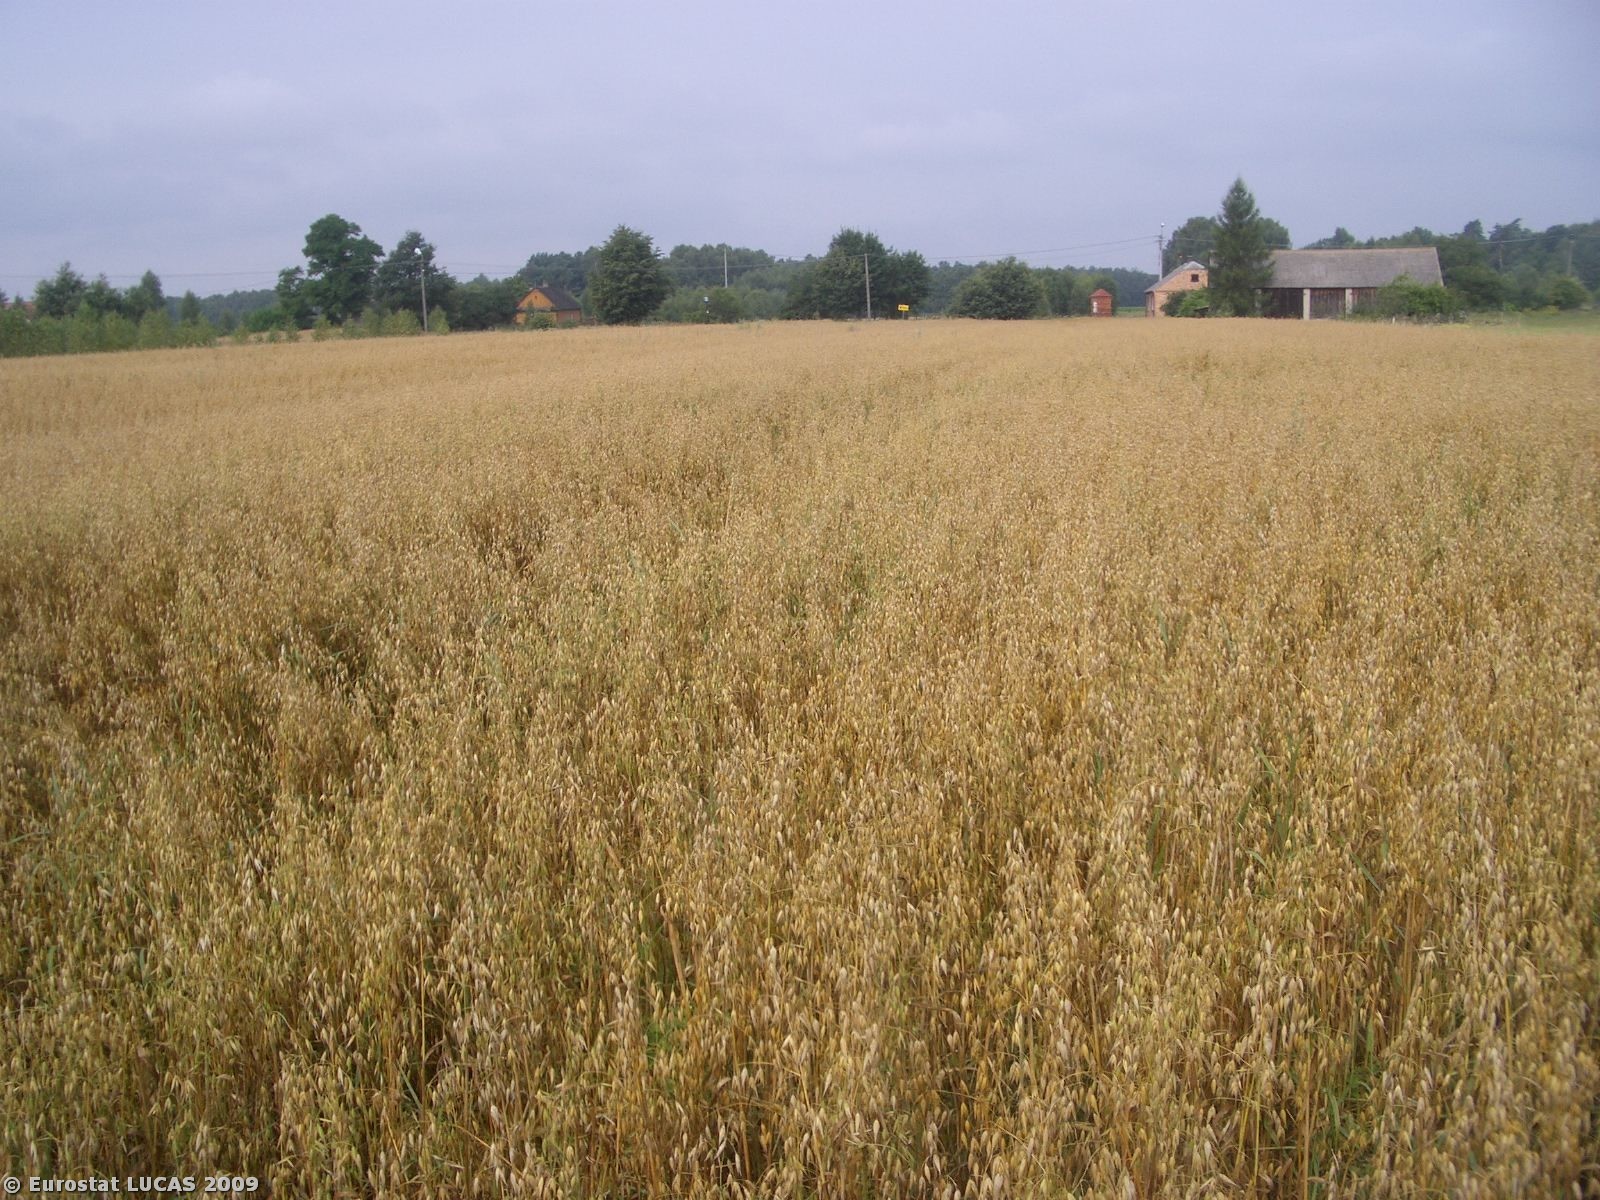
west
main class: Cropland
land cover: Oats
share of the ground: 50 - 75 %
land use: Agriculture (excluding fallow land and kitchen gardens)
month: August
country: PL
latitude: 51.9939
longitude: 23.2602
